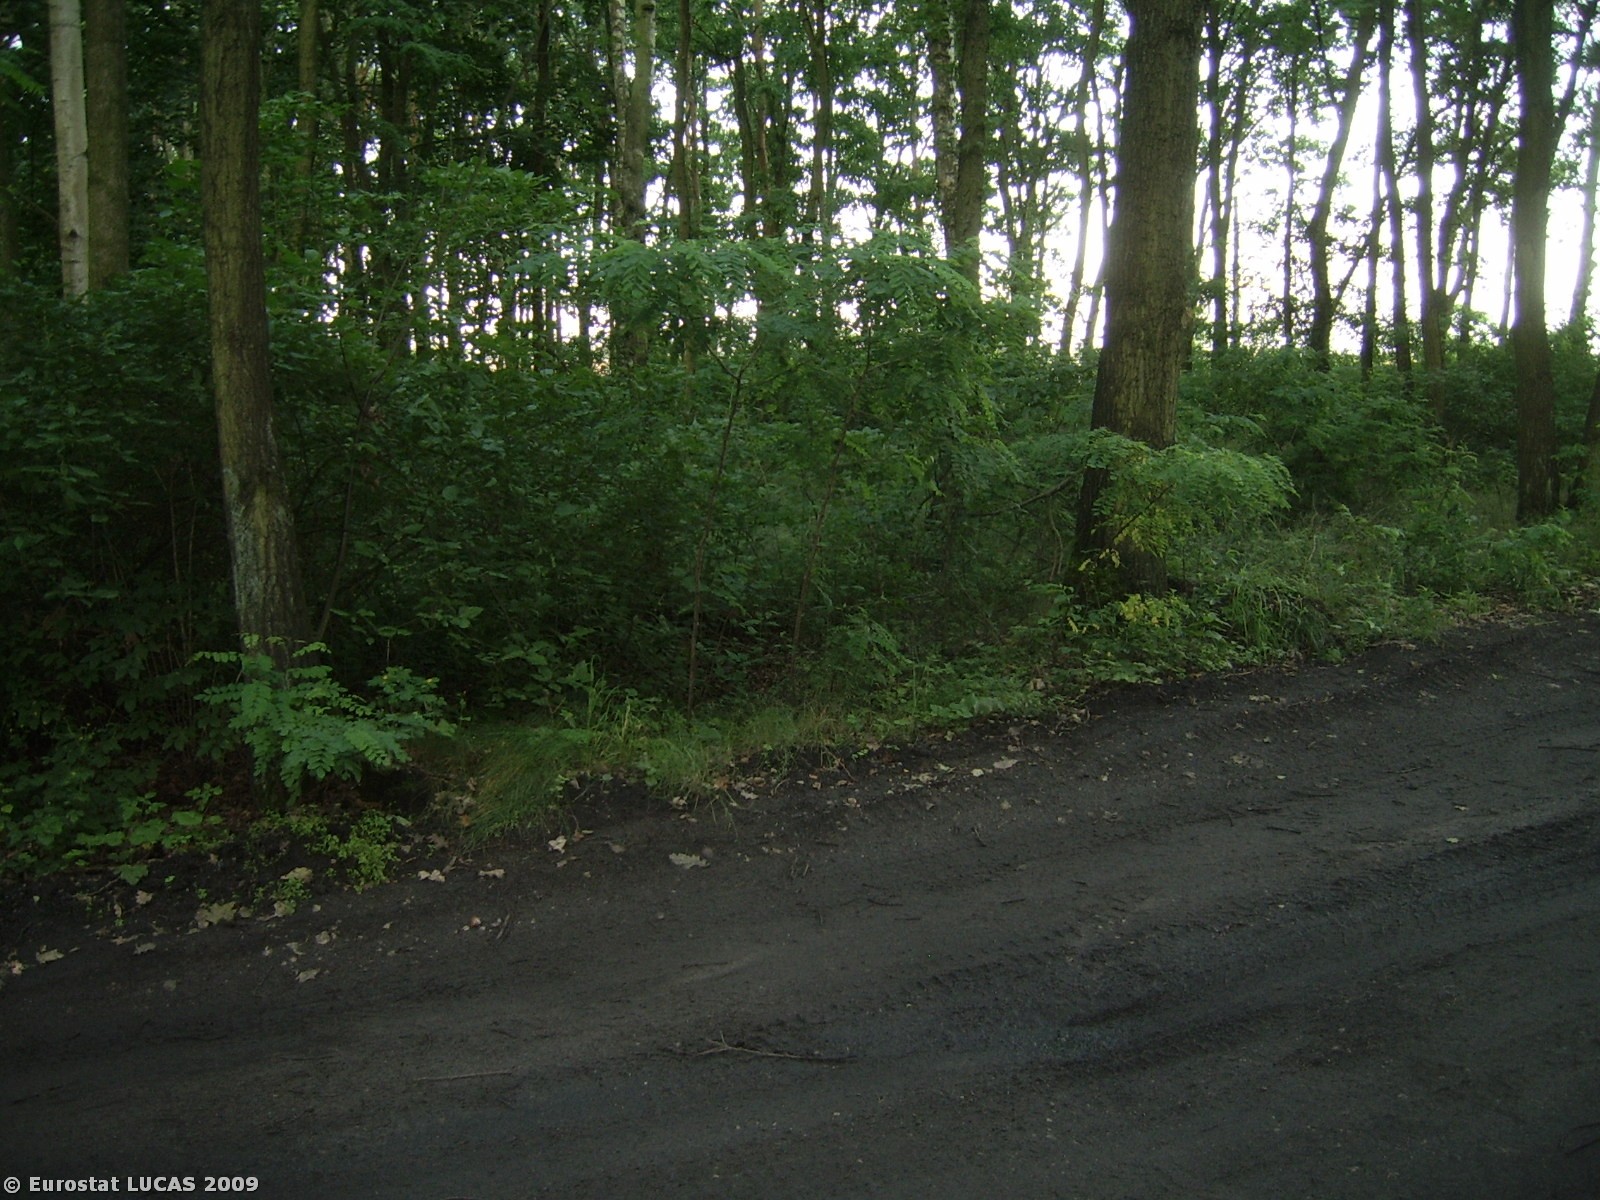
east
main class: Woodland
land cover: Mixed woodland
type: hemiboreal forest and nemoral coniferous forest and mixed broadleaved-coniferous forest
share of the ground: > 75 %
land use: Unused
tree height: > 5 m
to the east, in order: Mixed woodland; Paved roads, cycling and walking lanes; Mixed woodland; Fences; Artificial constructions in urban areas
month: July
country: PL
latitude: 53.1219
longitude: 17.6787
